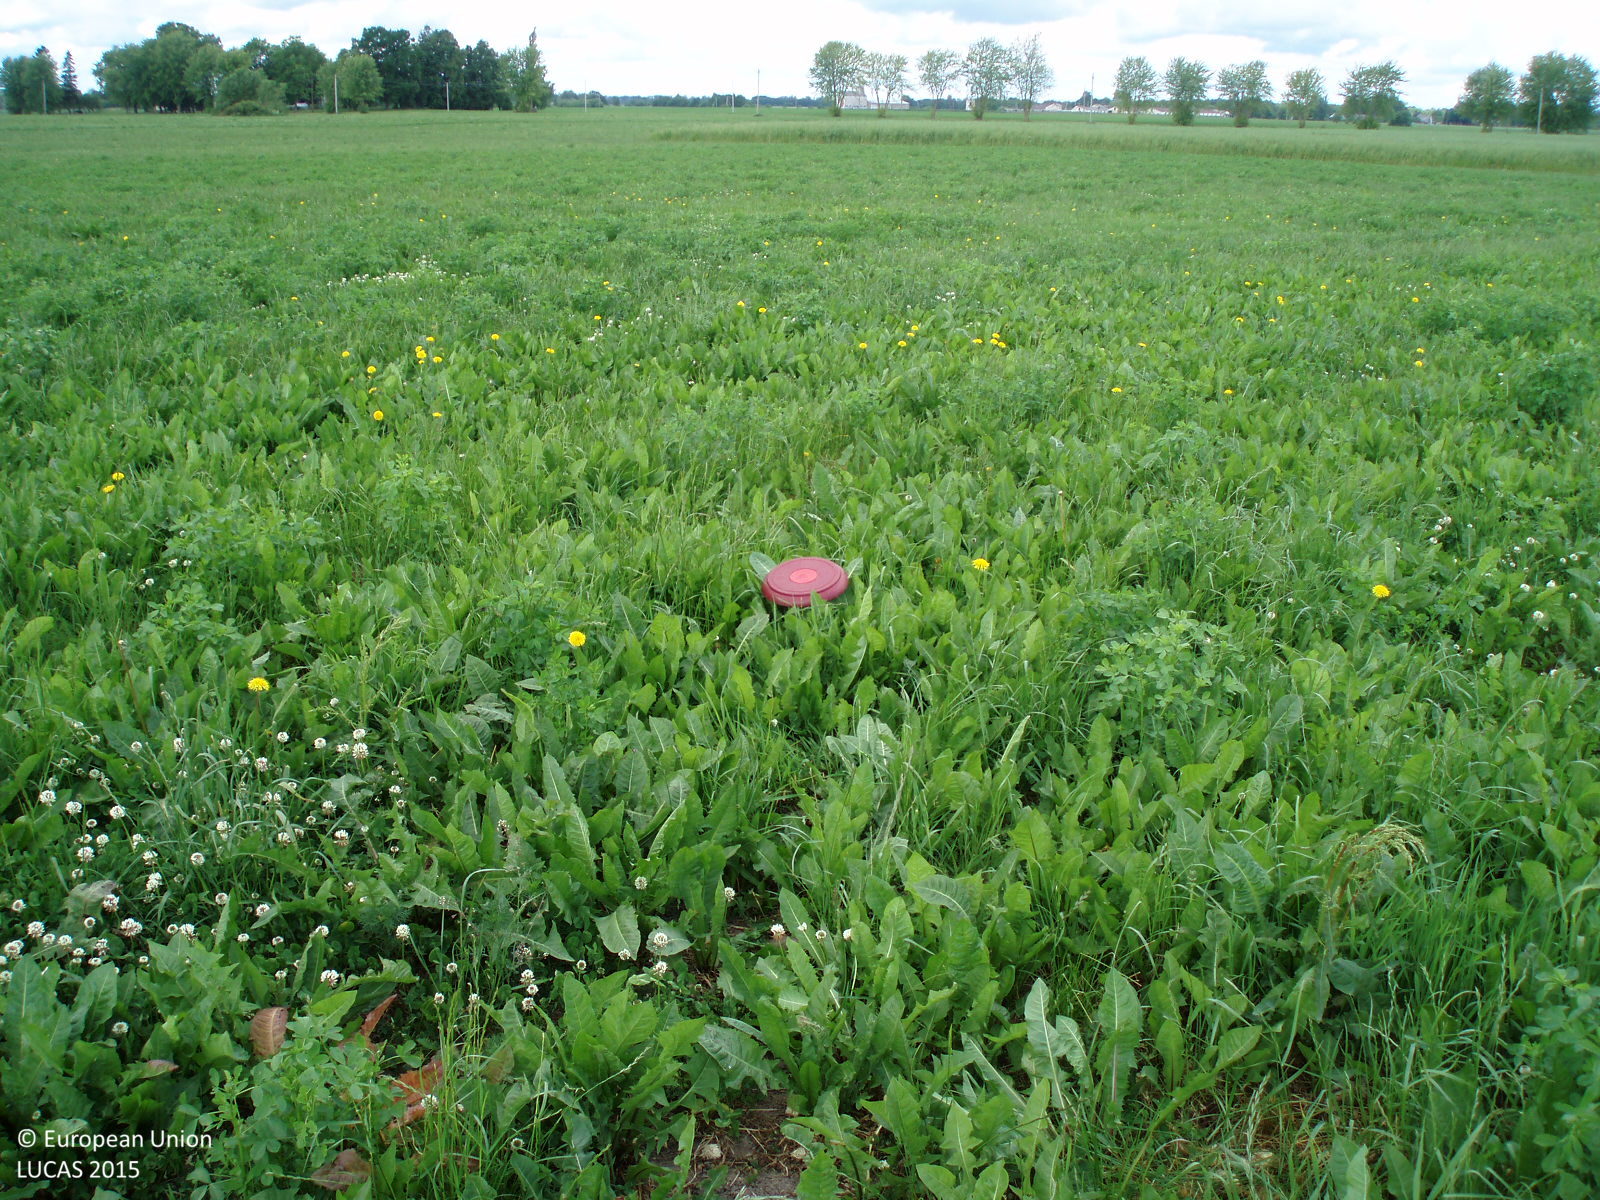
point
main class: Cropland
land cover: Other leguminous and mixtures for fodder
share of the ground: > 75 %
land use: Agriculture (excluding fallow land and kitchen gardens)
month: June
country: LT
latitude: 56.3191
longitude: 23.4131
